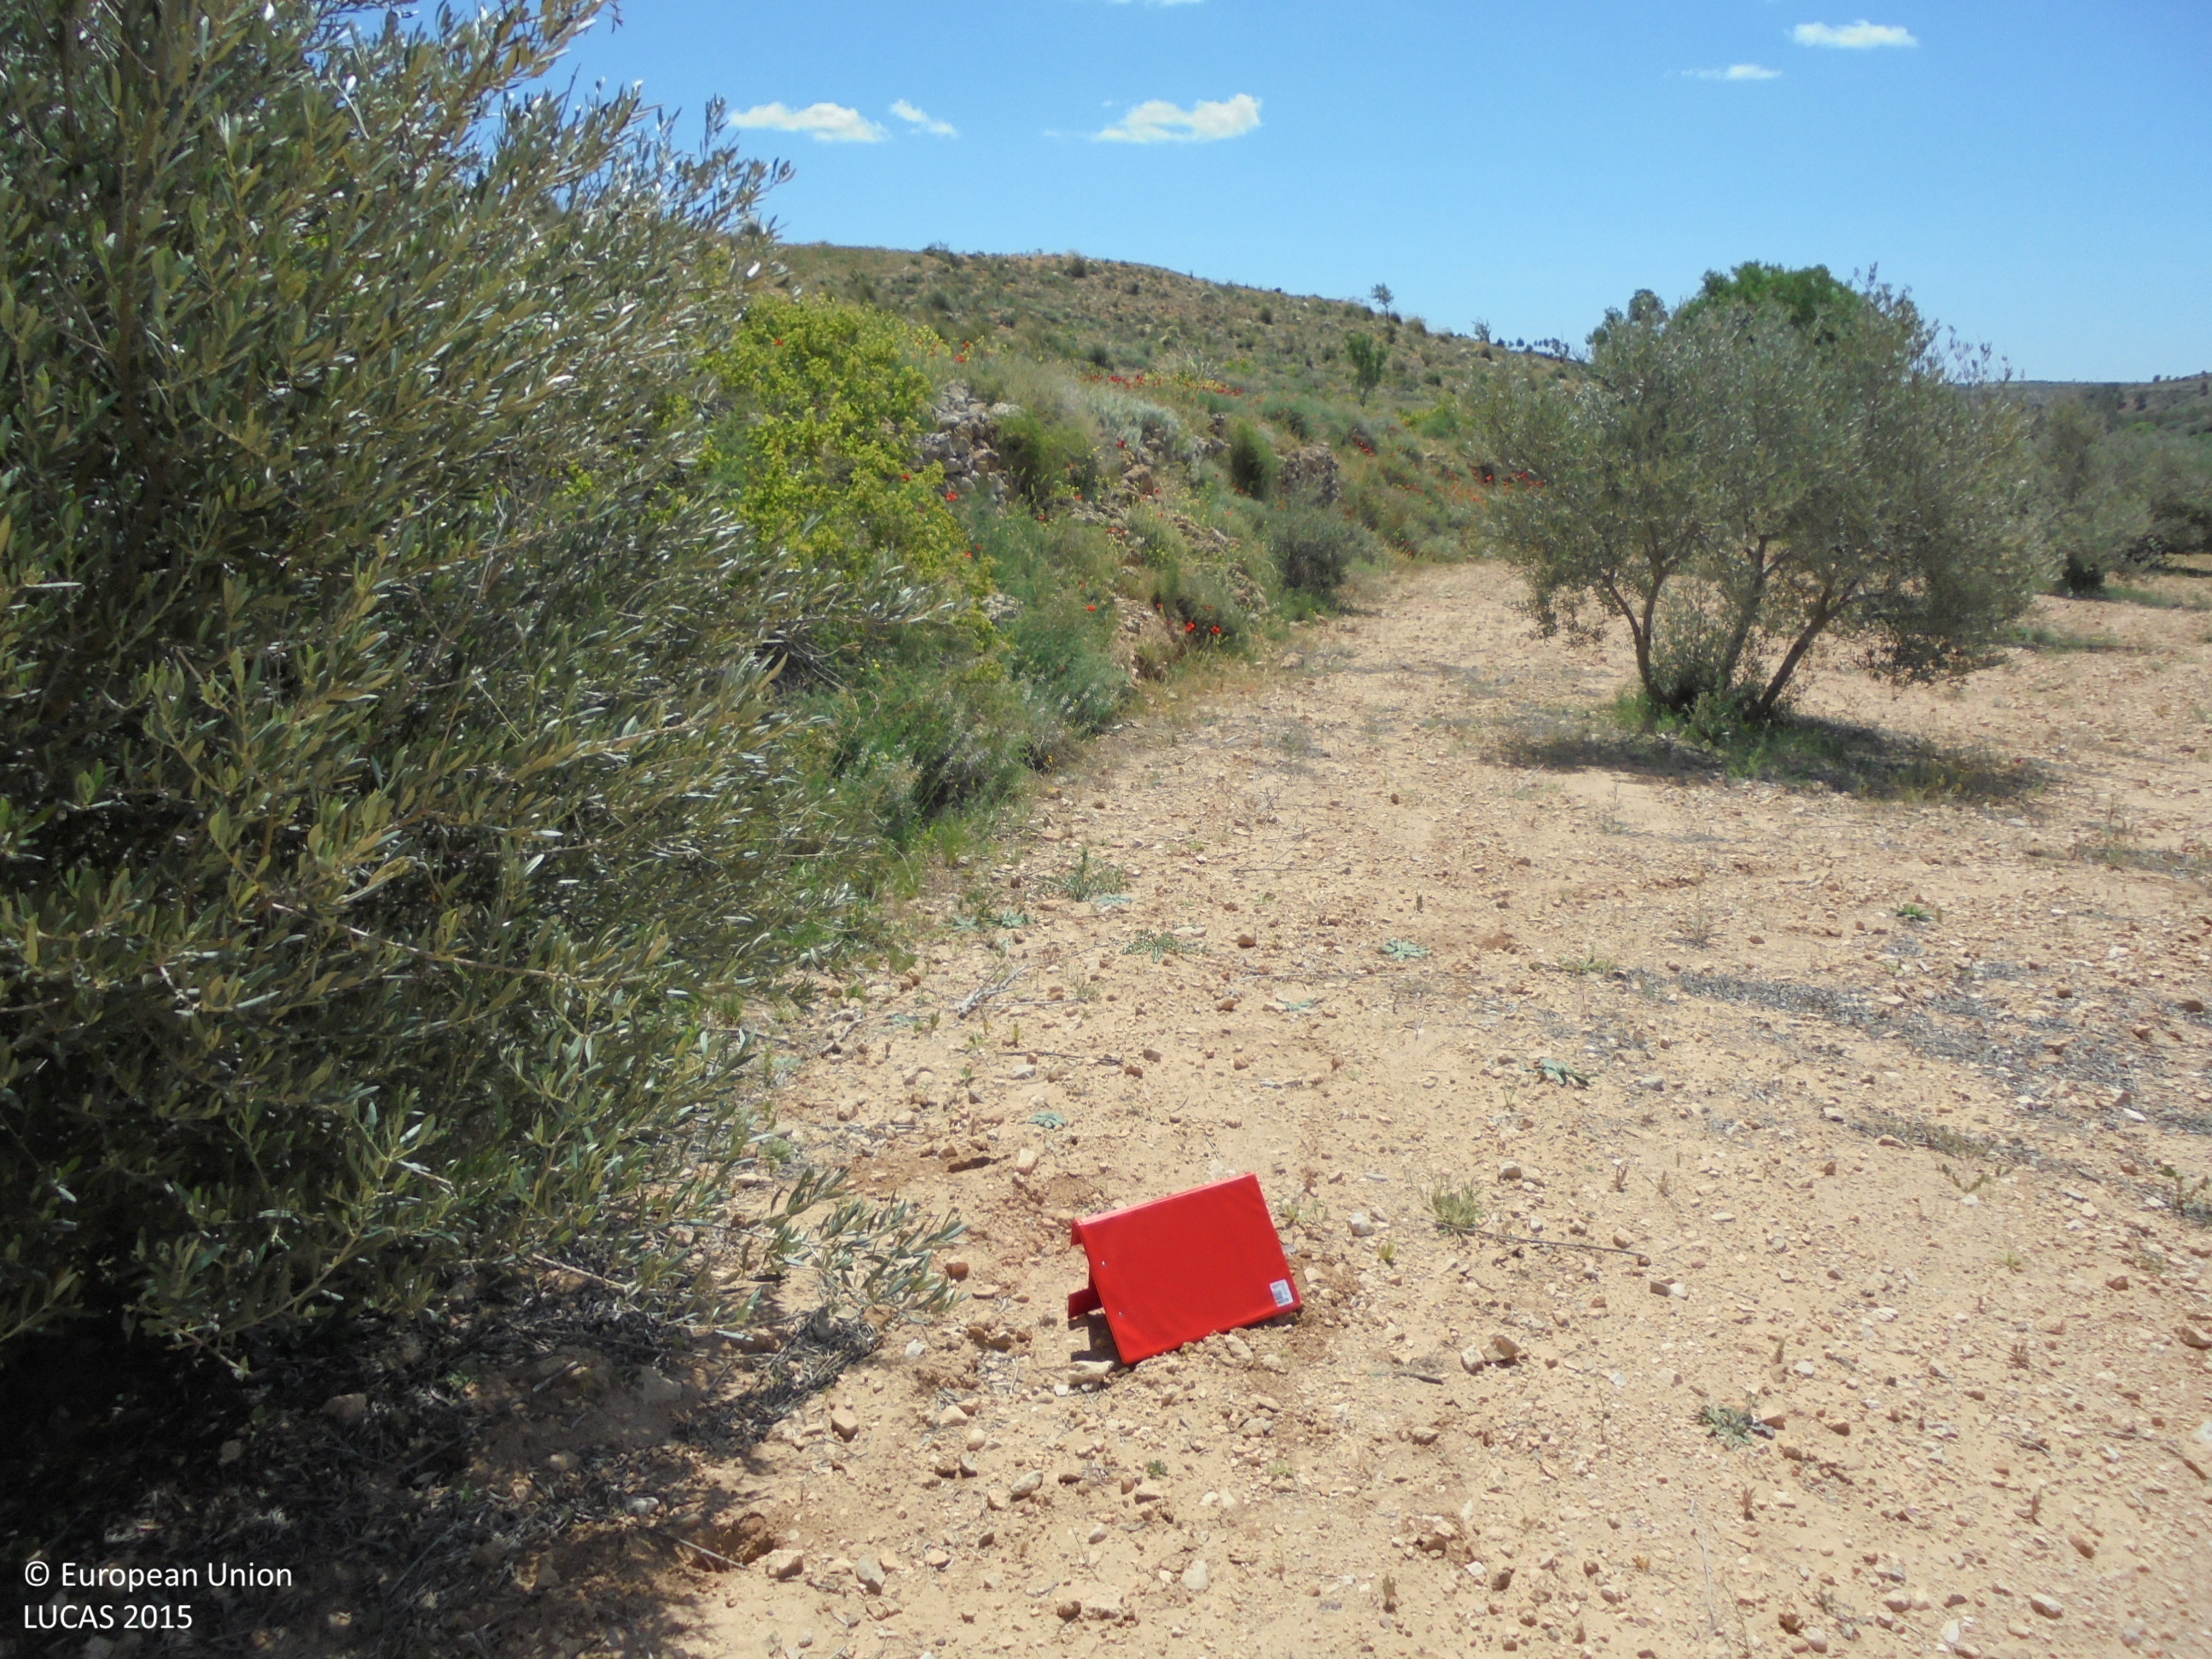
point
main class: Cropland
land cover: Olive groves
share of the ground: 10 - 25 %
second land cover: Spontaneously vegetated surfaces
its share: 10 - 25 %
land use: Agriculture (excluding fallow land and kitchen gardens)
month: May
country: ES
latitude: 39.2176
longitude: -1.5485
